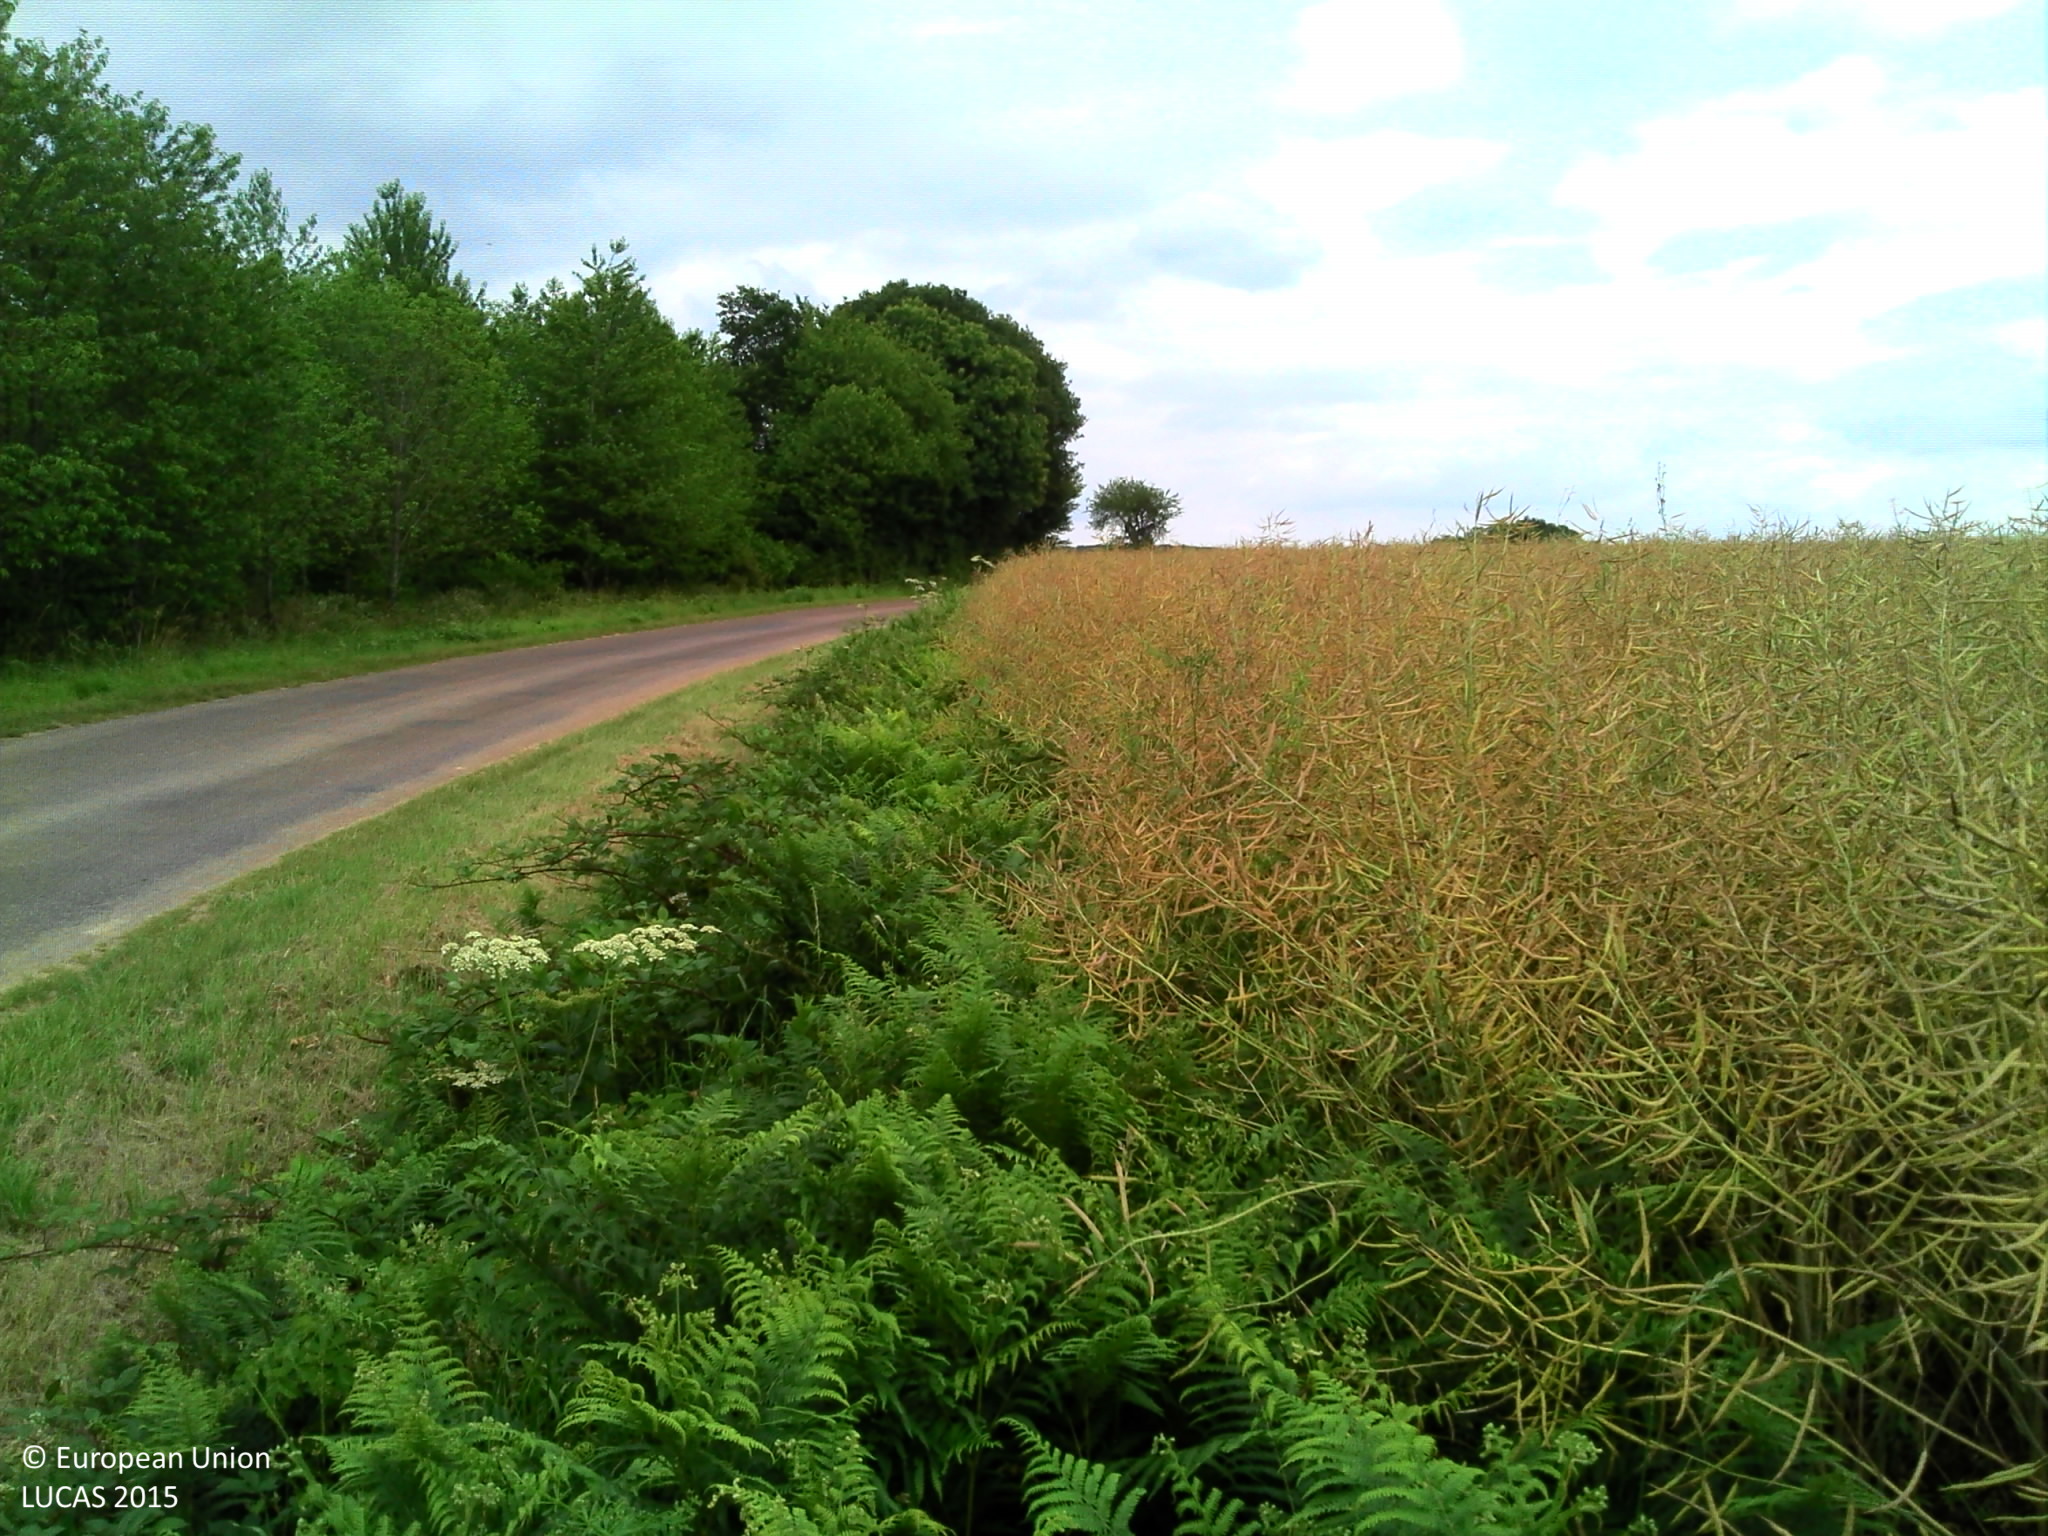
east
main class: Cropland
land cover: Rape and turnip rape
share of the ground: > 75 %
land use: Agriculture (excluding fallow land and kitchen gardens)
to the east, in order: Rape and turnip rape
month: June
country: FR
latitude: 47.3227
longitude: 3.1285
